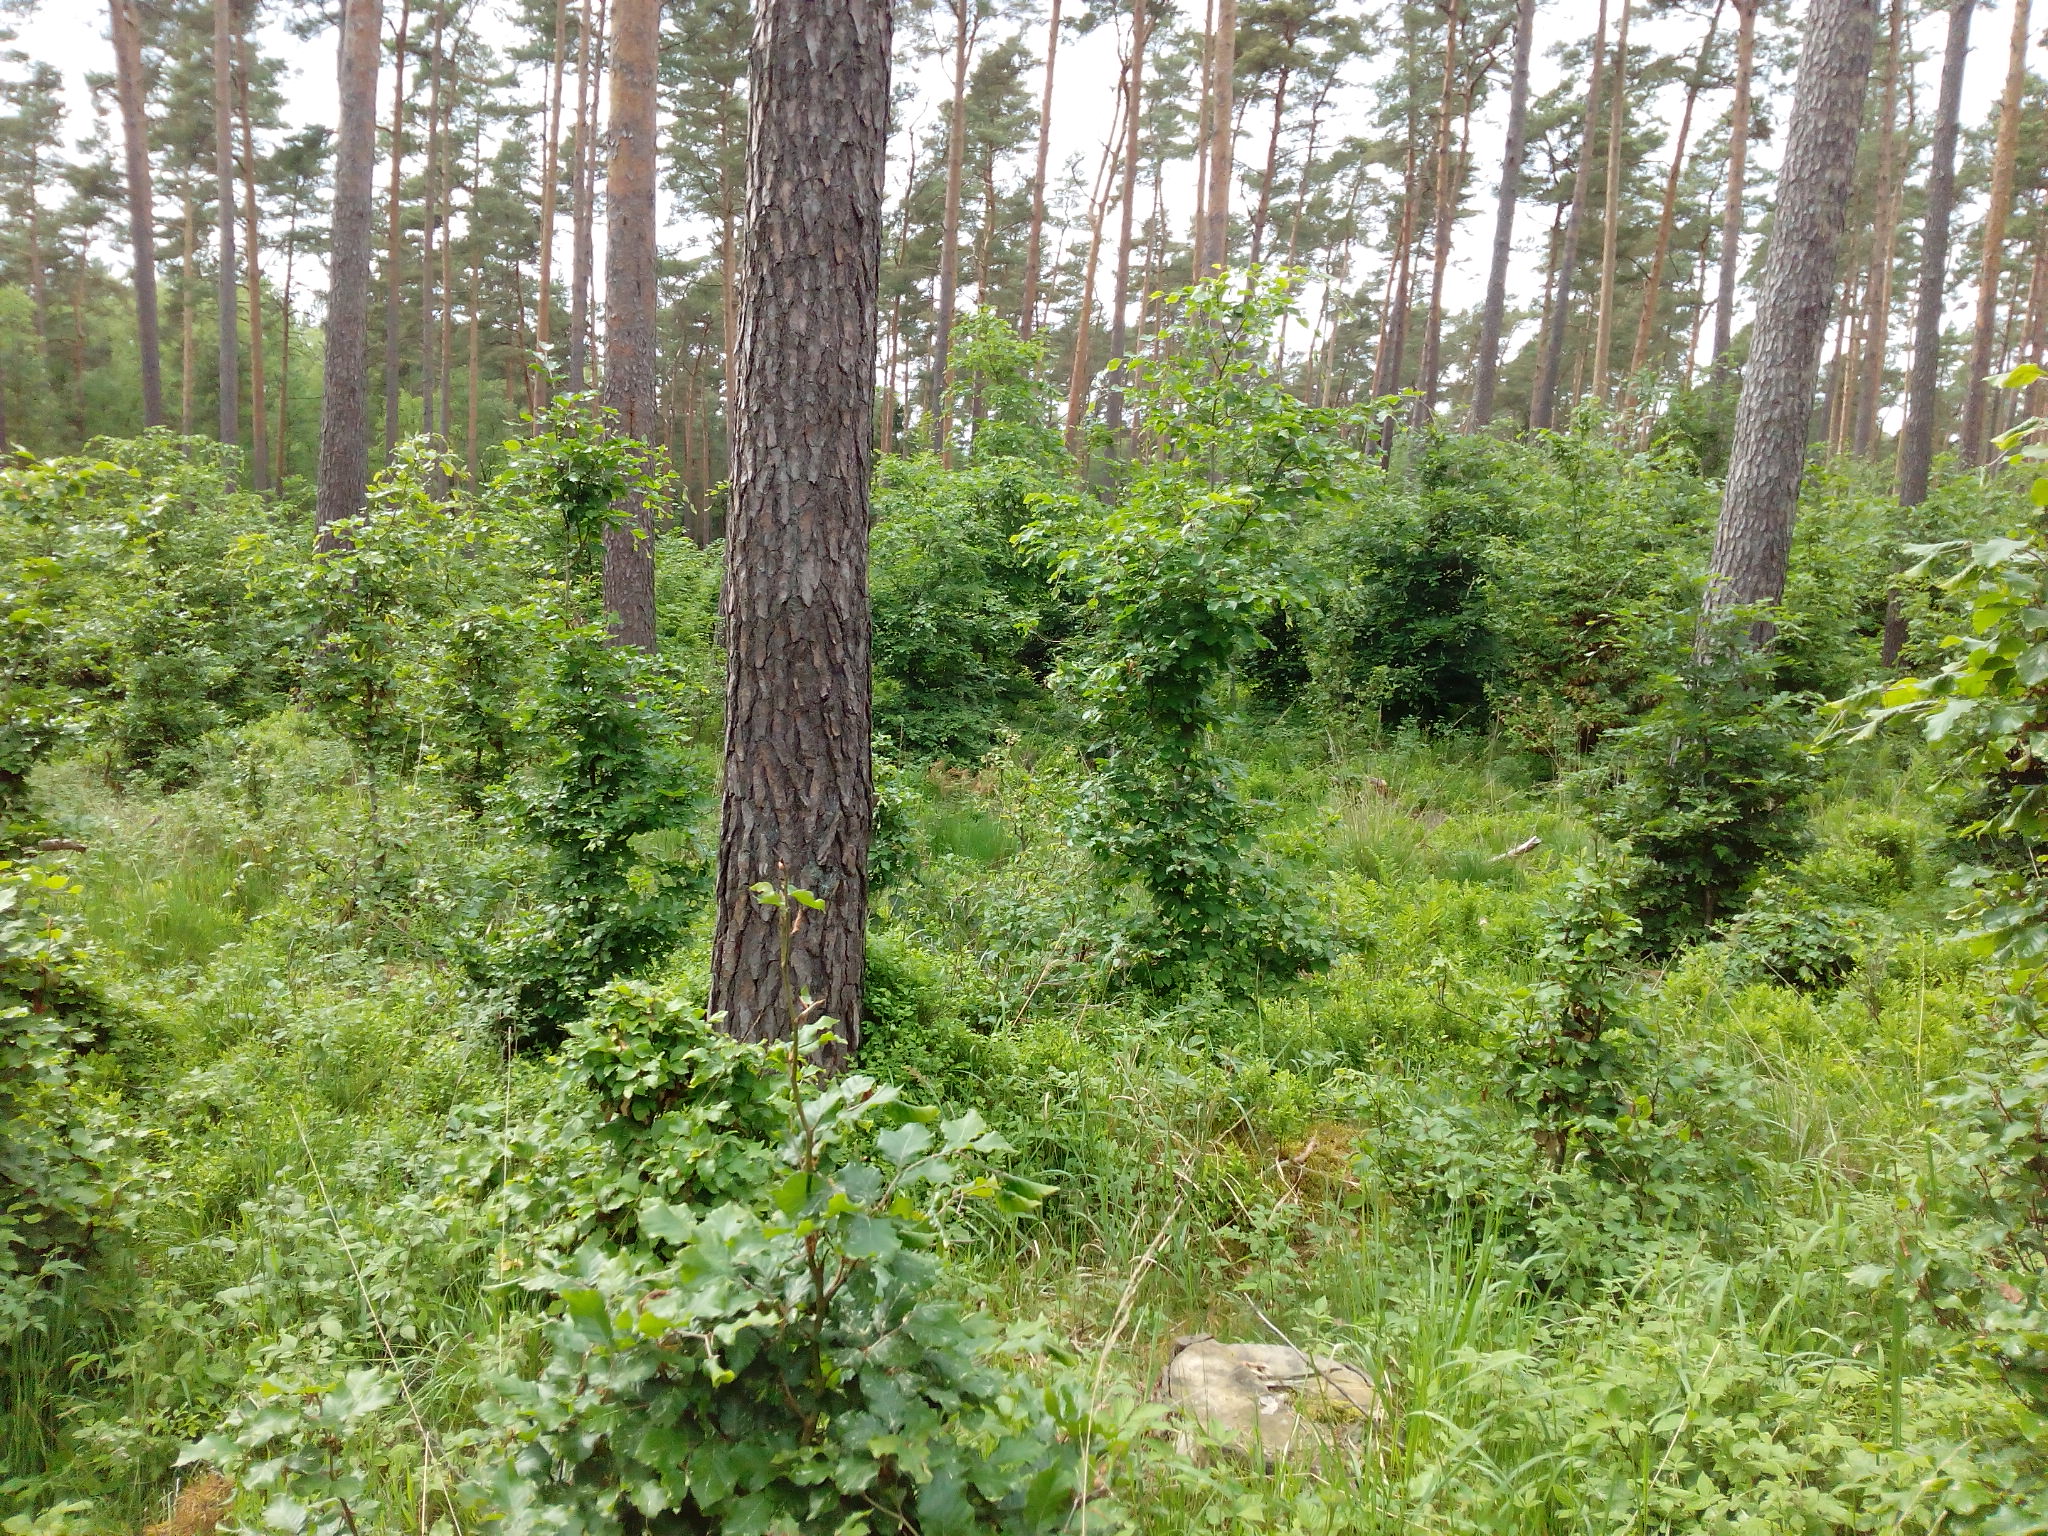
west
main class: Woodland
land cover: Pine dominated mixed woodland
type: hemiboreal forest and nemoral coniferous forest and mixed broadleaved-coniferous forest
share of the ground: > 75 %
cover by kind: coniferous forest trees 50 %, broadleaved forest trees 20 %, shrubs 20 %, herbaceous plants 10 %
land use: Forestry
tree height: > 5 m
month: June
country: DE
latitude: 52.6111
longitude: 9.9262
